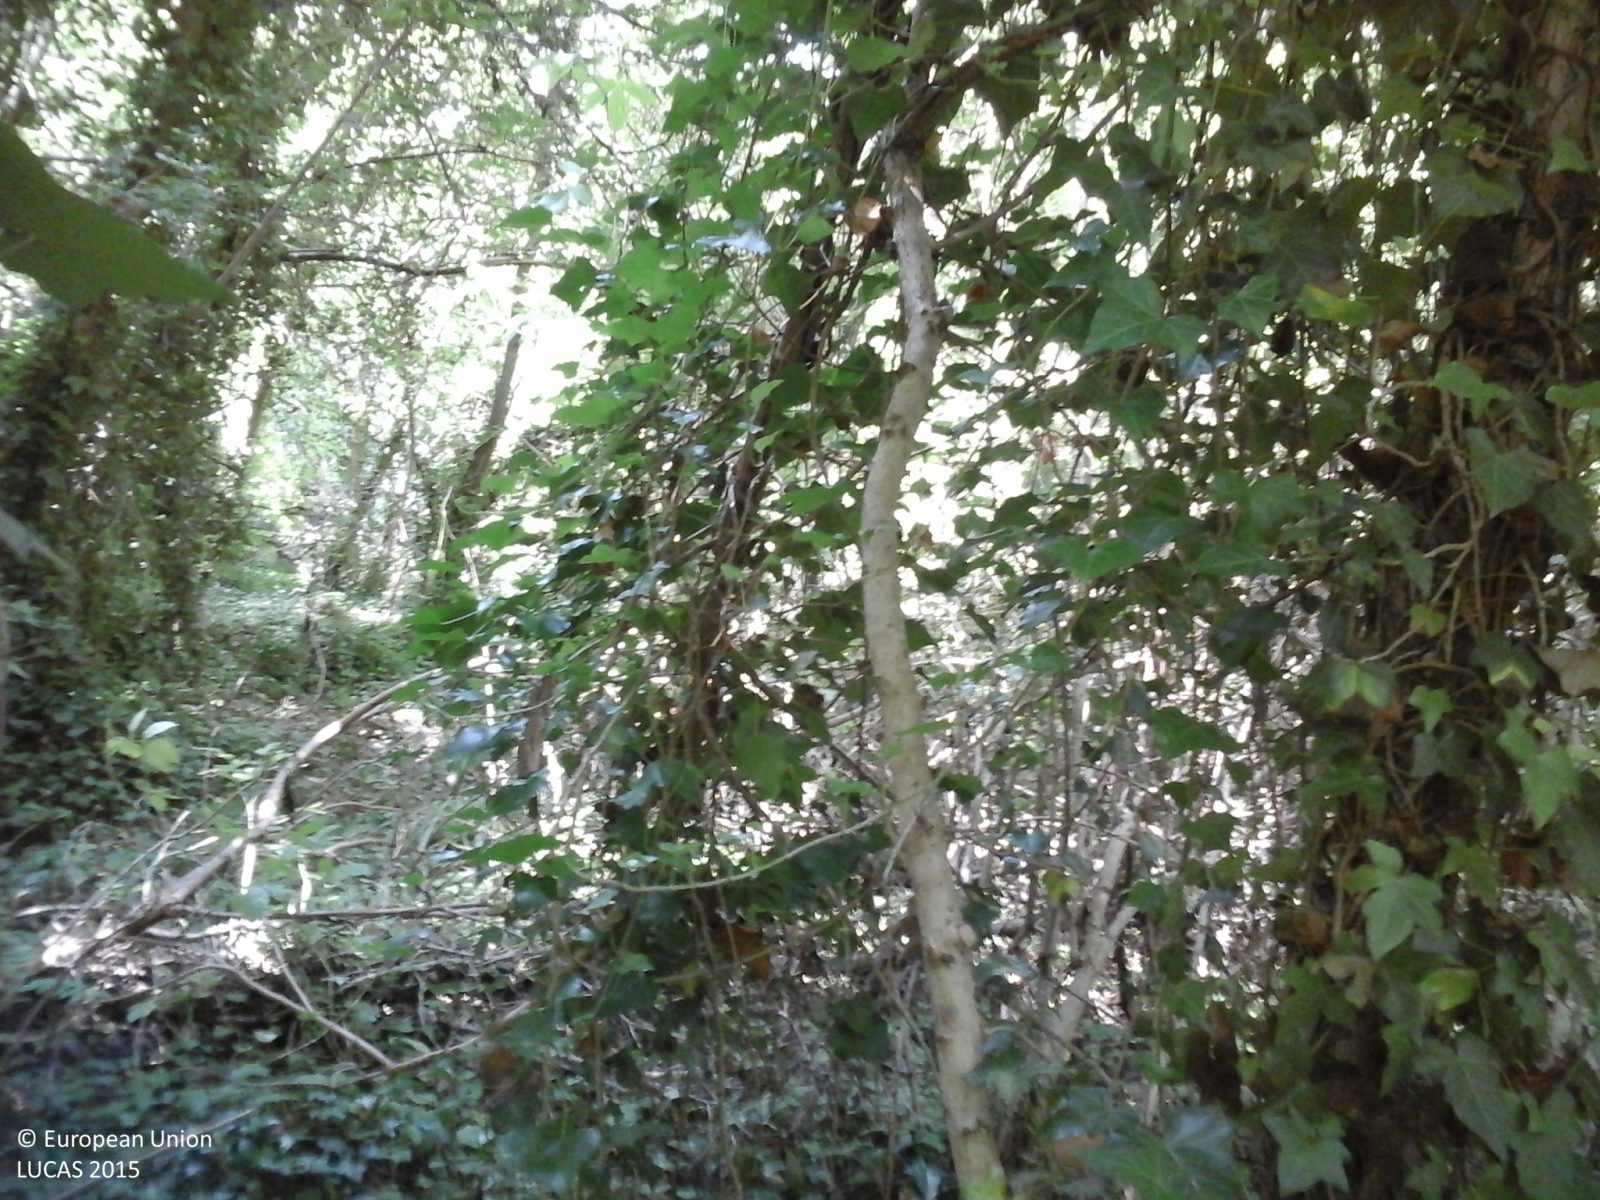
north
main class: Woodland
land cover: Broadleaved woodland
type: thermophilous deciduous forest
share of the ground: > 75 %
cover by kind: broadleaved forest trees 100 %
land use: Forestry
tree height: > 5 m
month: August
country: IT
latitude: 43.0654
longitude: 13.4413
